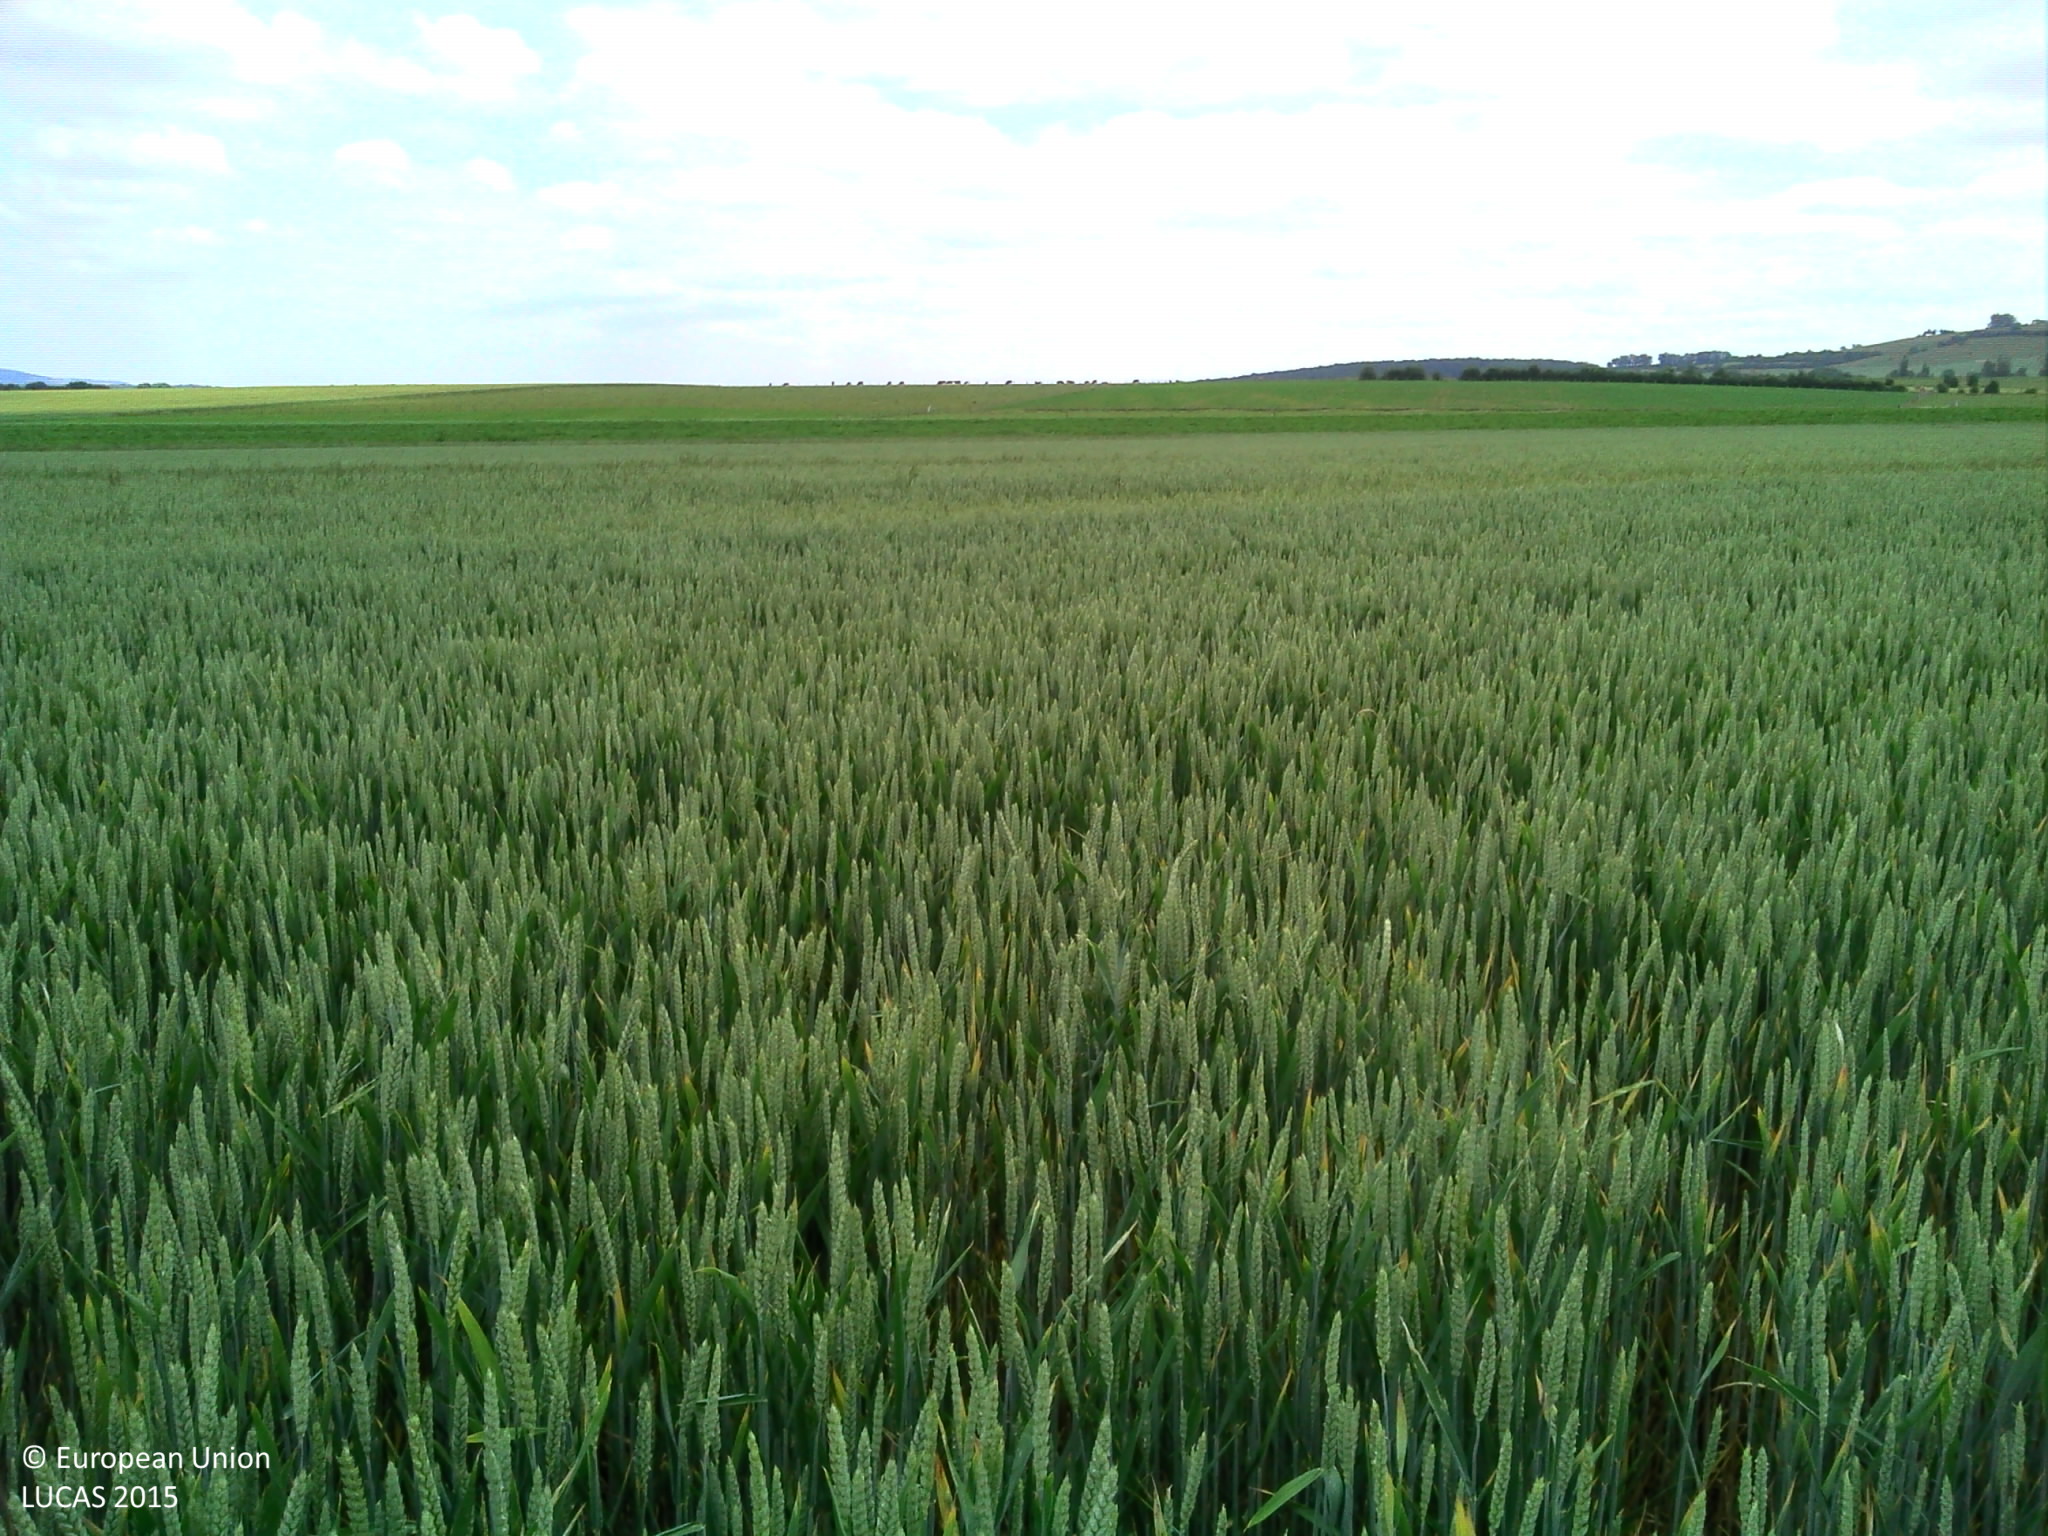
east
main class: Cropland
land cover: Common wheat
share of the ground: > 75 %
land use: Agriculture (excluding fallow land and kitchen gardens)
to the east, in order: Common wheat; Grassland without tree/shrub cover; Rivers and streams; Grassland without tree/shrub cover; Common wheat; Dry pulses
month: June
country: FR
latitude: 48.8605
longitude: 6.1969
